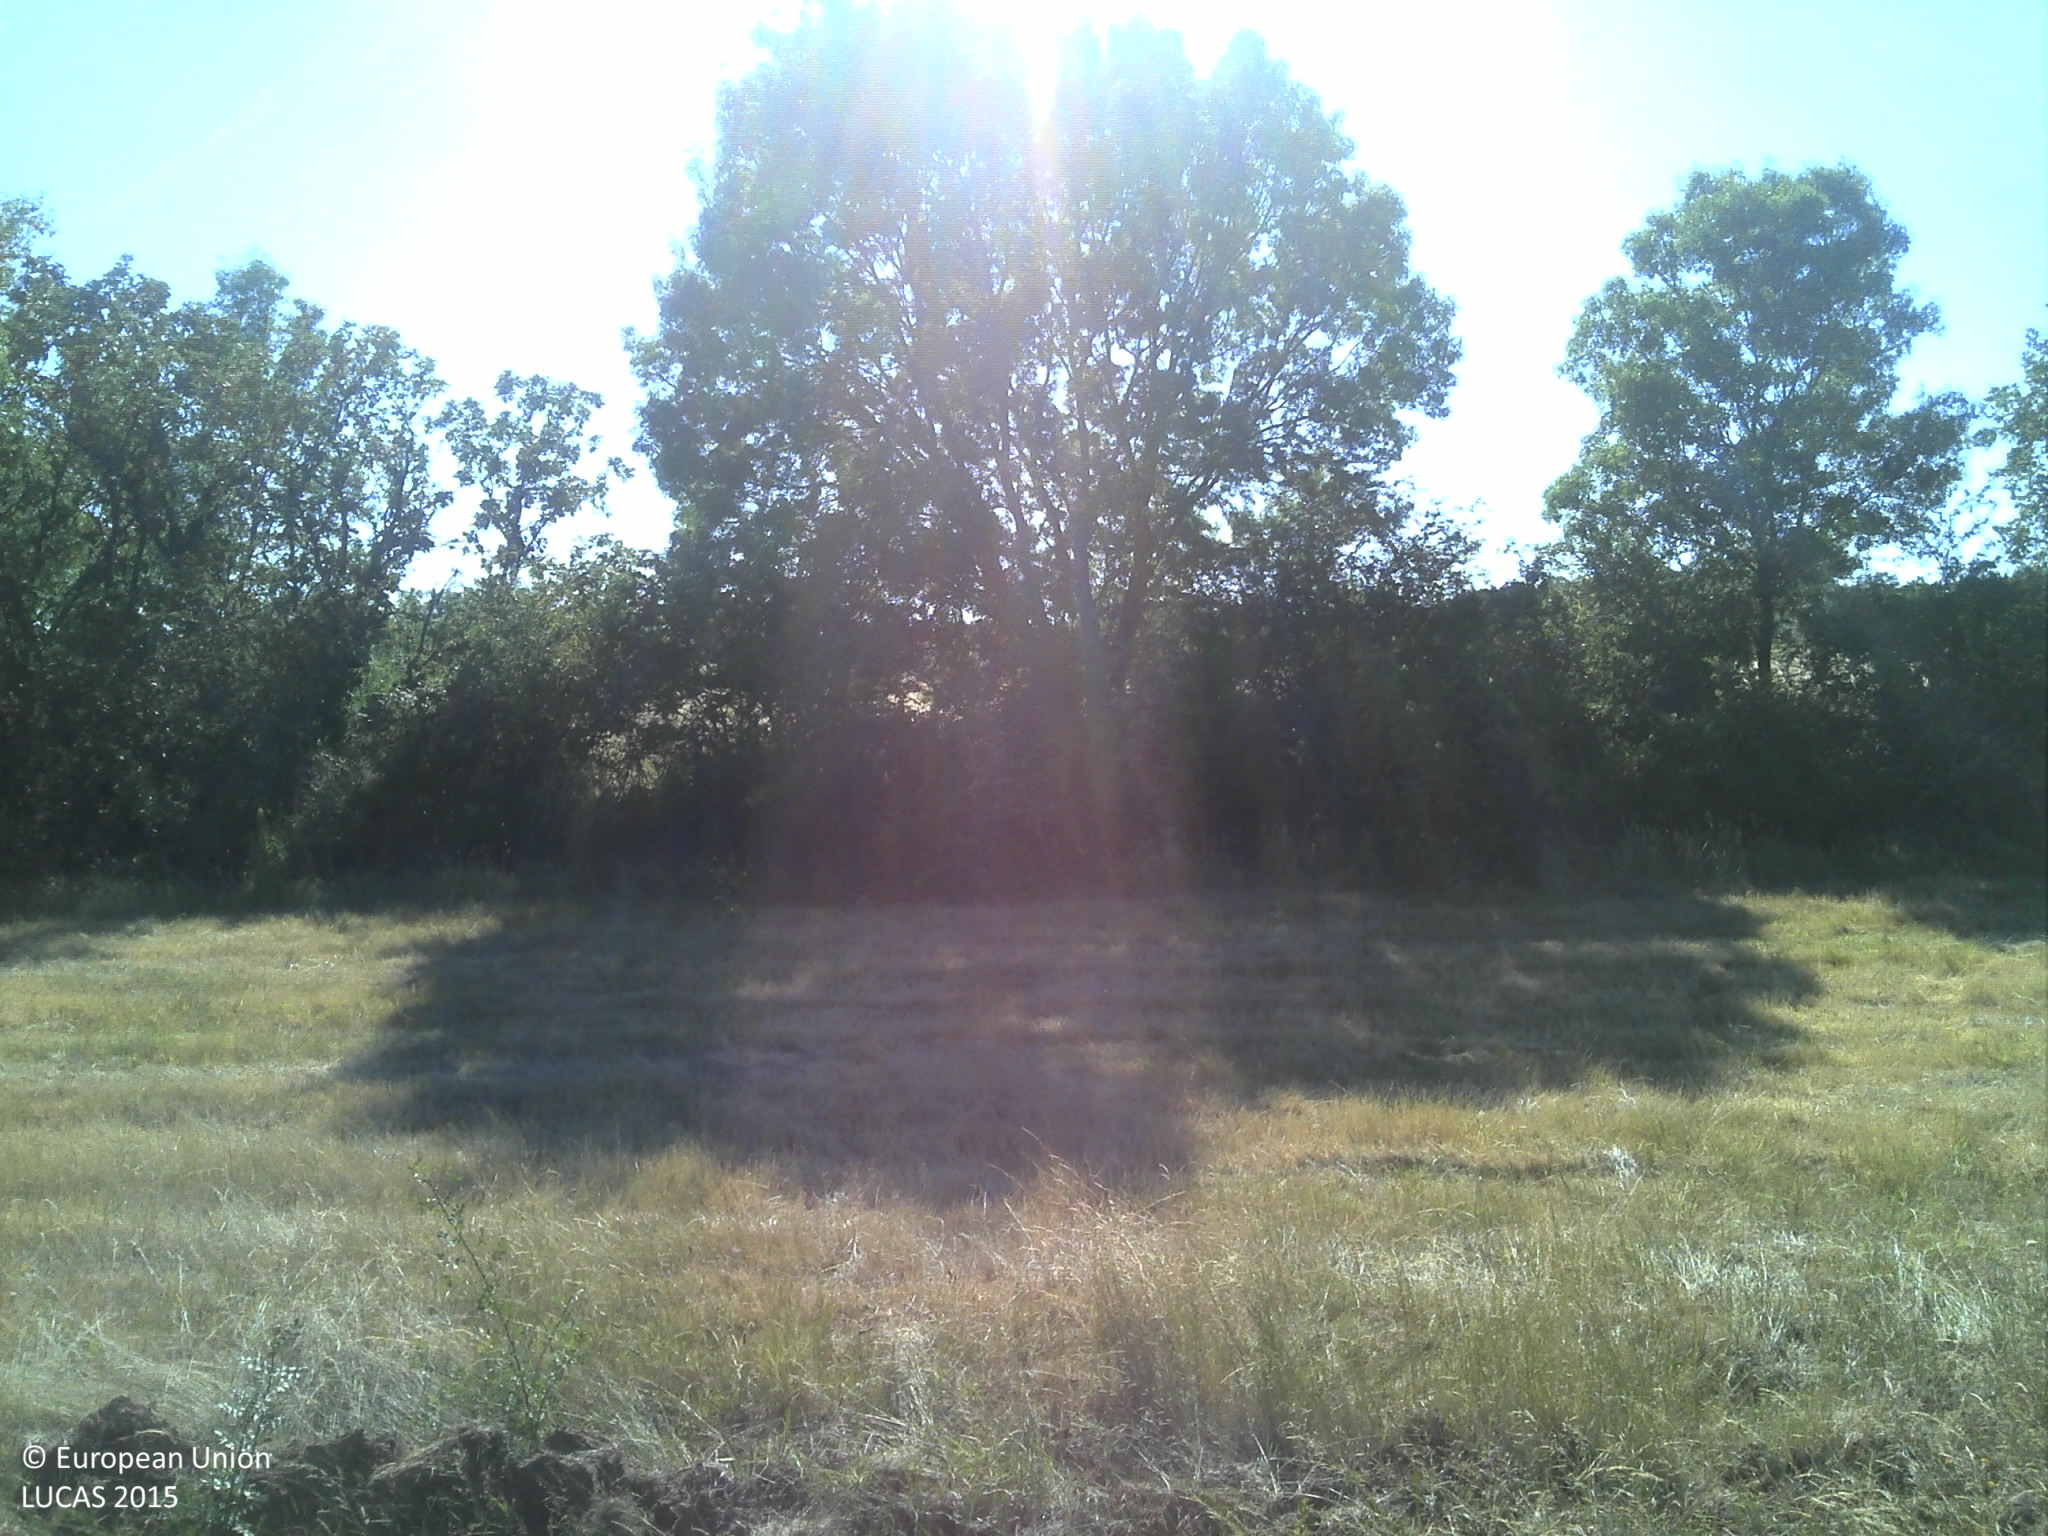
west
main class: Cropland
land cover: Olive groves
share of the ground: 25 - 50 %
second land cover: Spontaneously vegetated surfaces
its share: 10 - 25 %
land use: Agriculture (excluding fallow land and kitchen gardens)
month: June
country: PT
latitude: 40.0159
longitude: -7.2607
